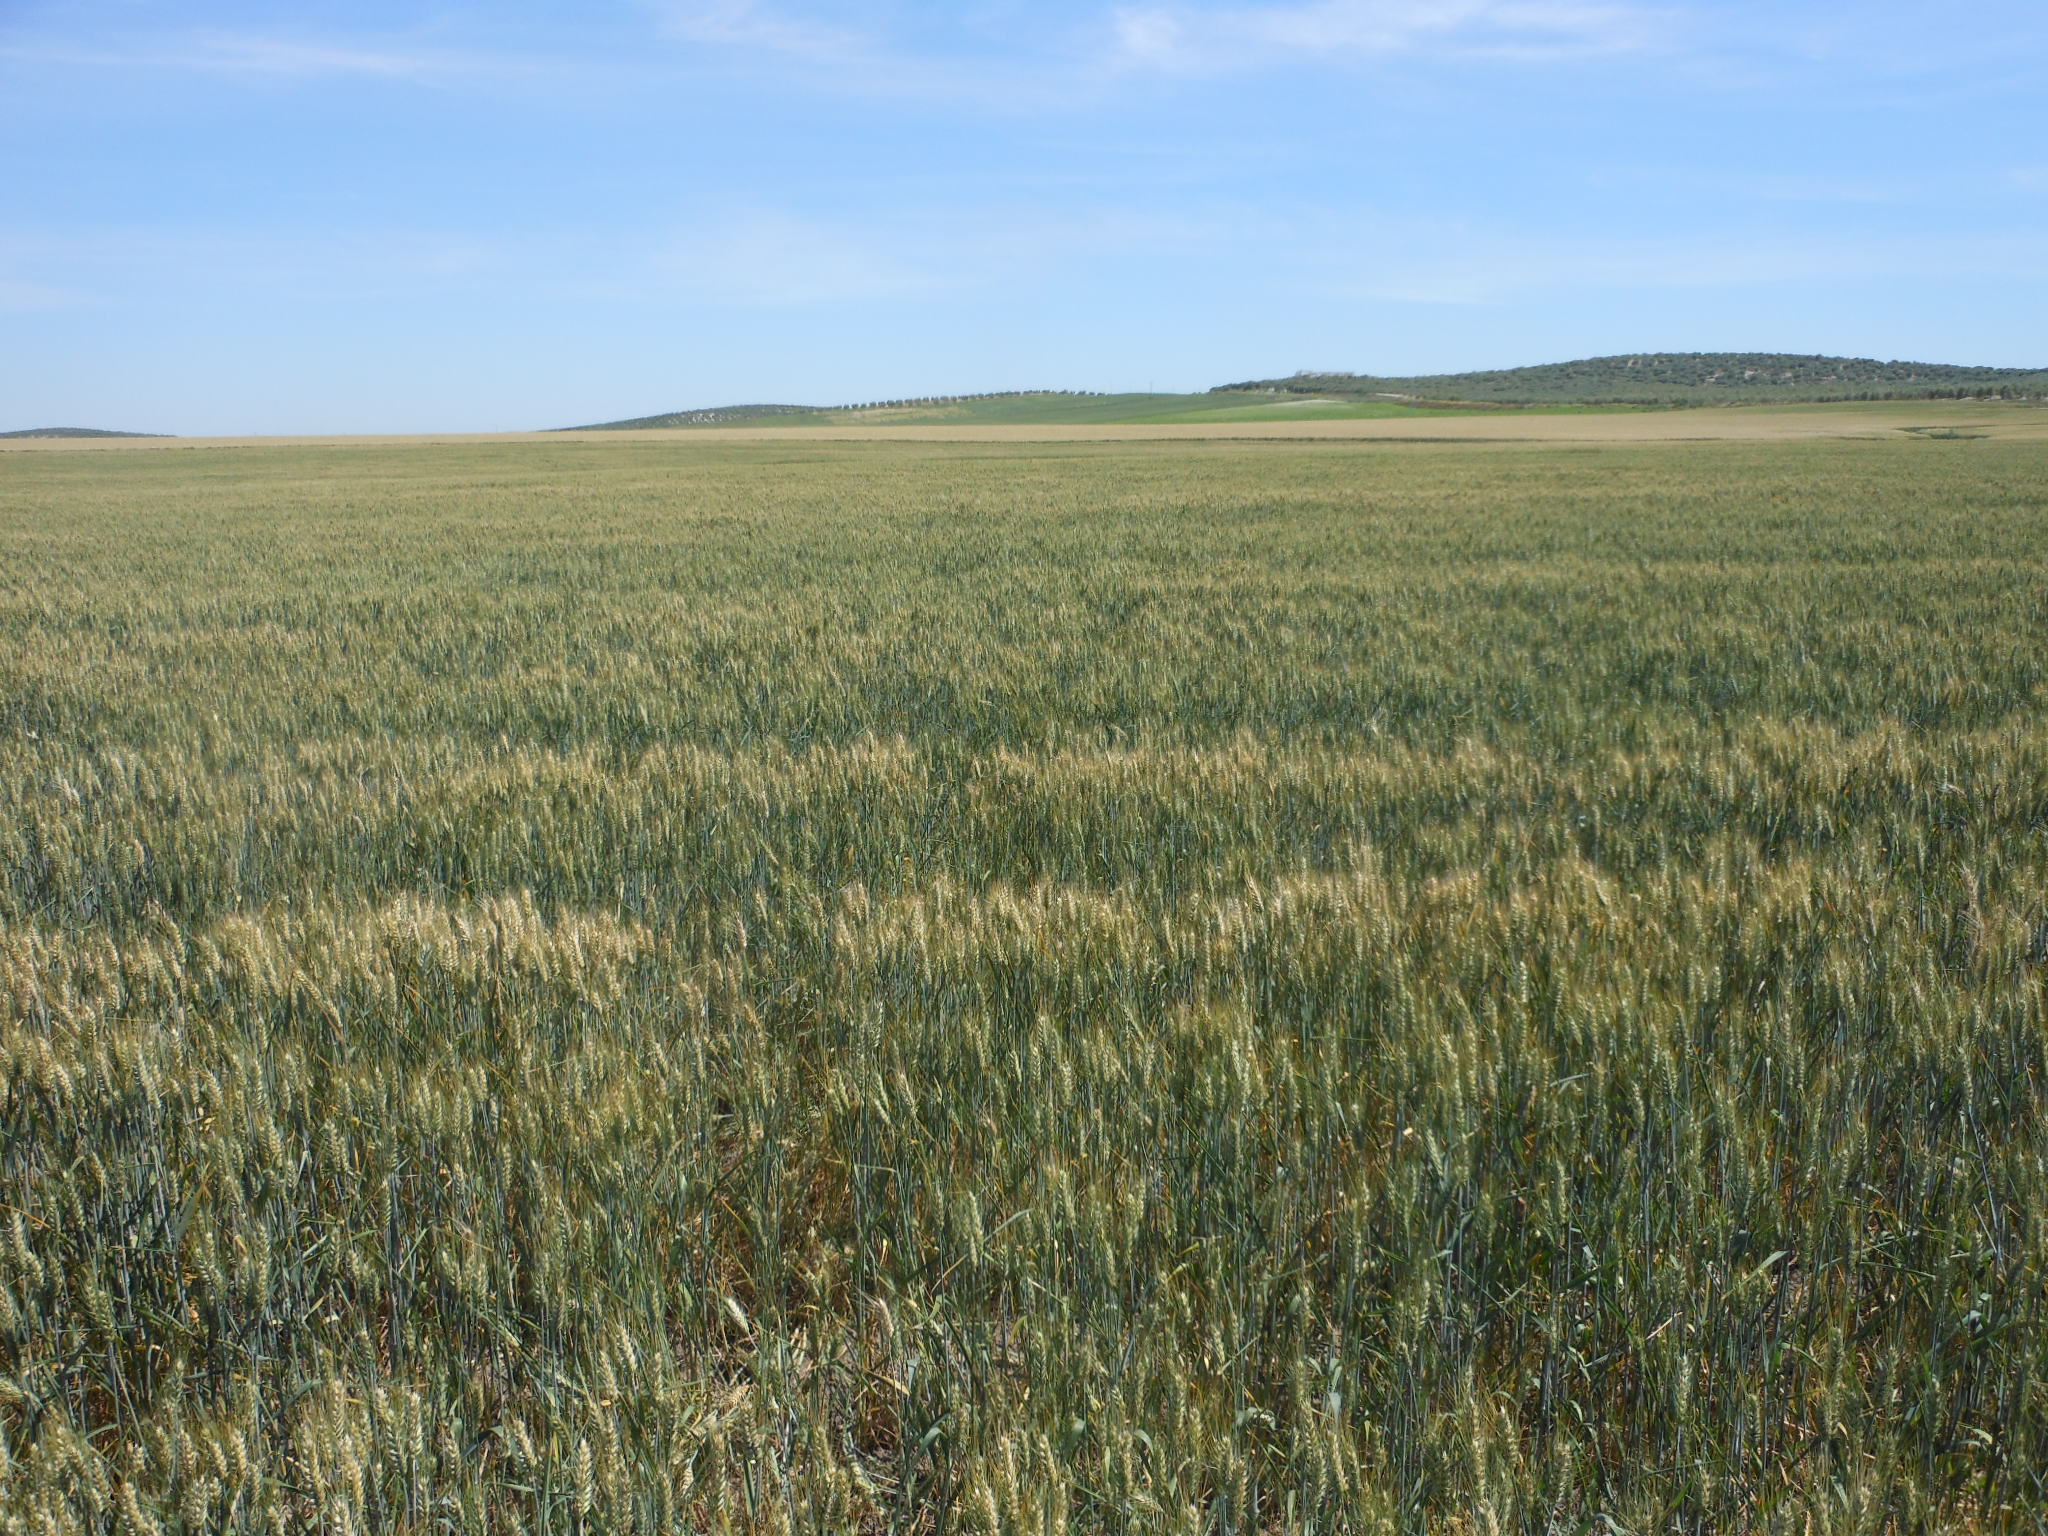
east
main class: Cropland
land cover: Durum wheat
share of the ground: 50 - 75 %
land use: Agriculture (excluding fallow land and kitchen gardens)
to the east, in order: Durum wheat; Rivers and streams; Durum wheat; Grass margins; Durum wheat
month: April
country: ES
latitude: 37.4173
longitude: -5.5535
